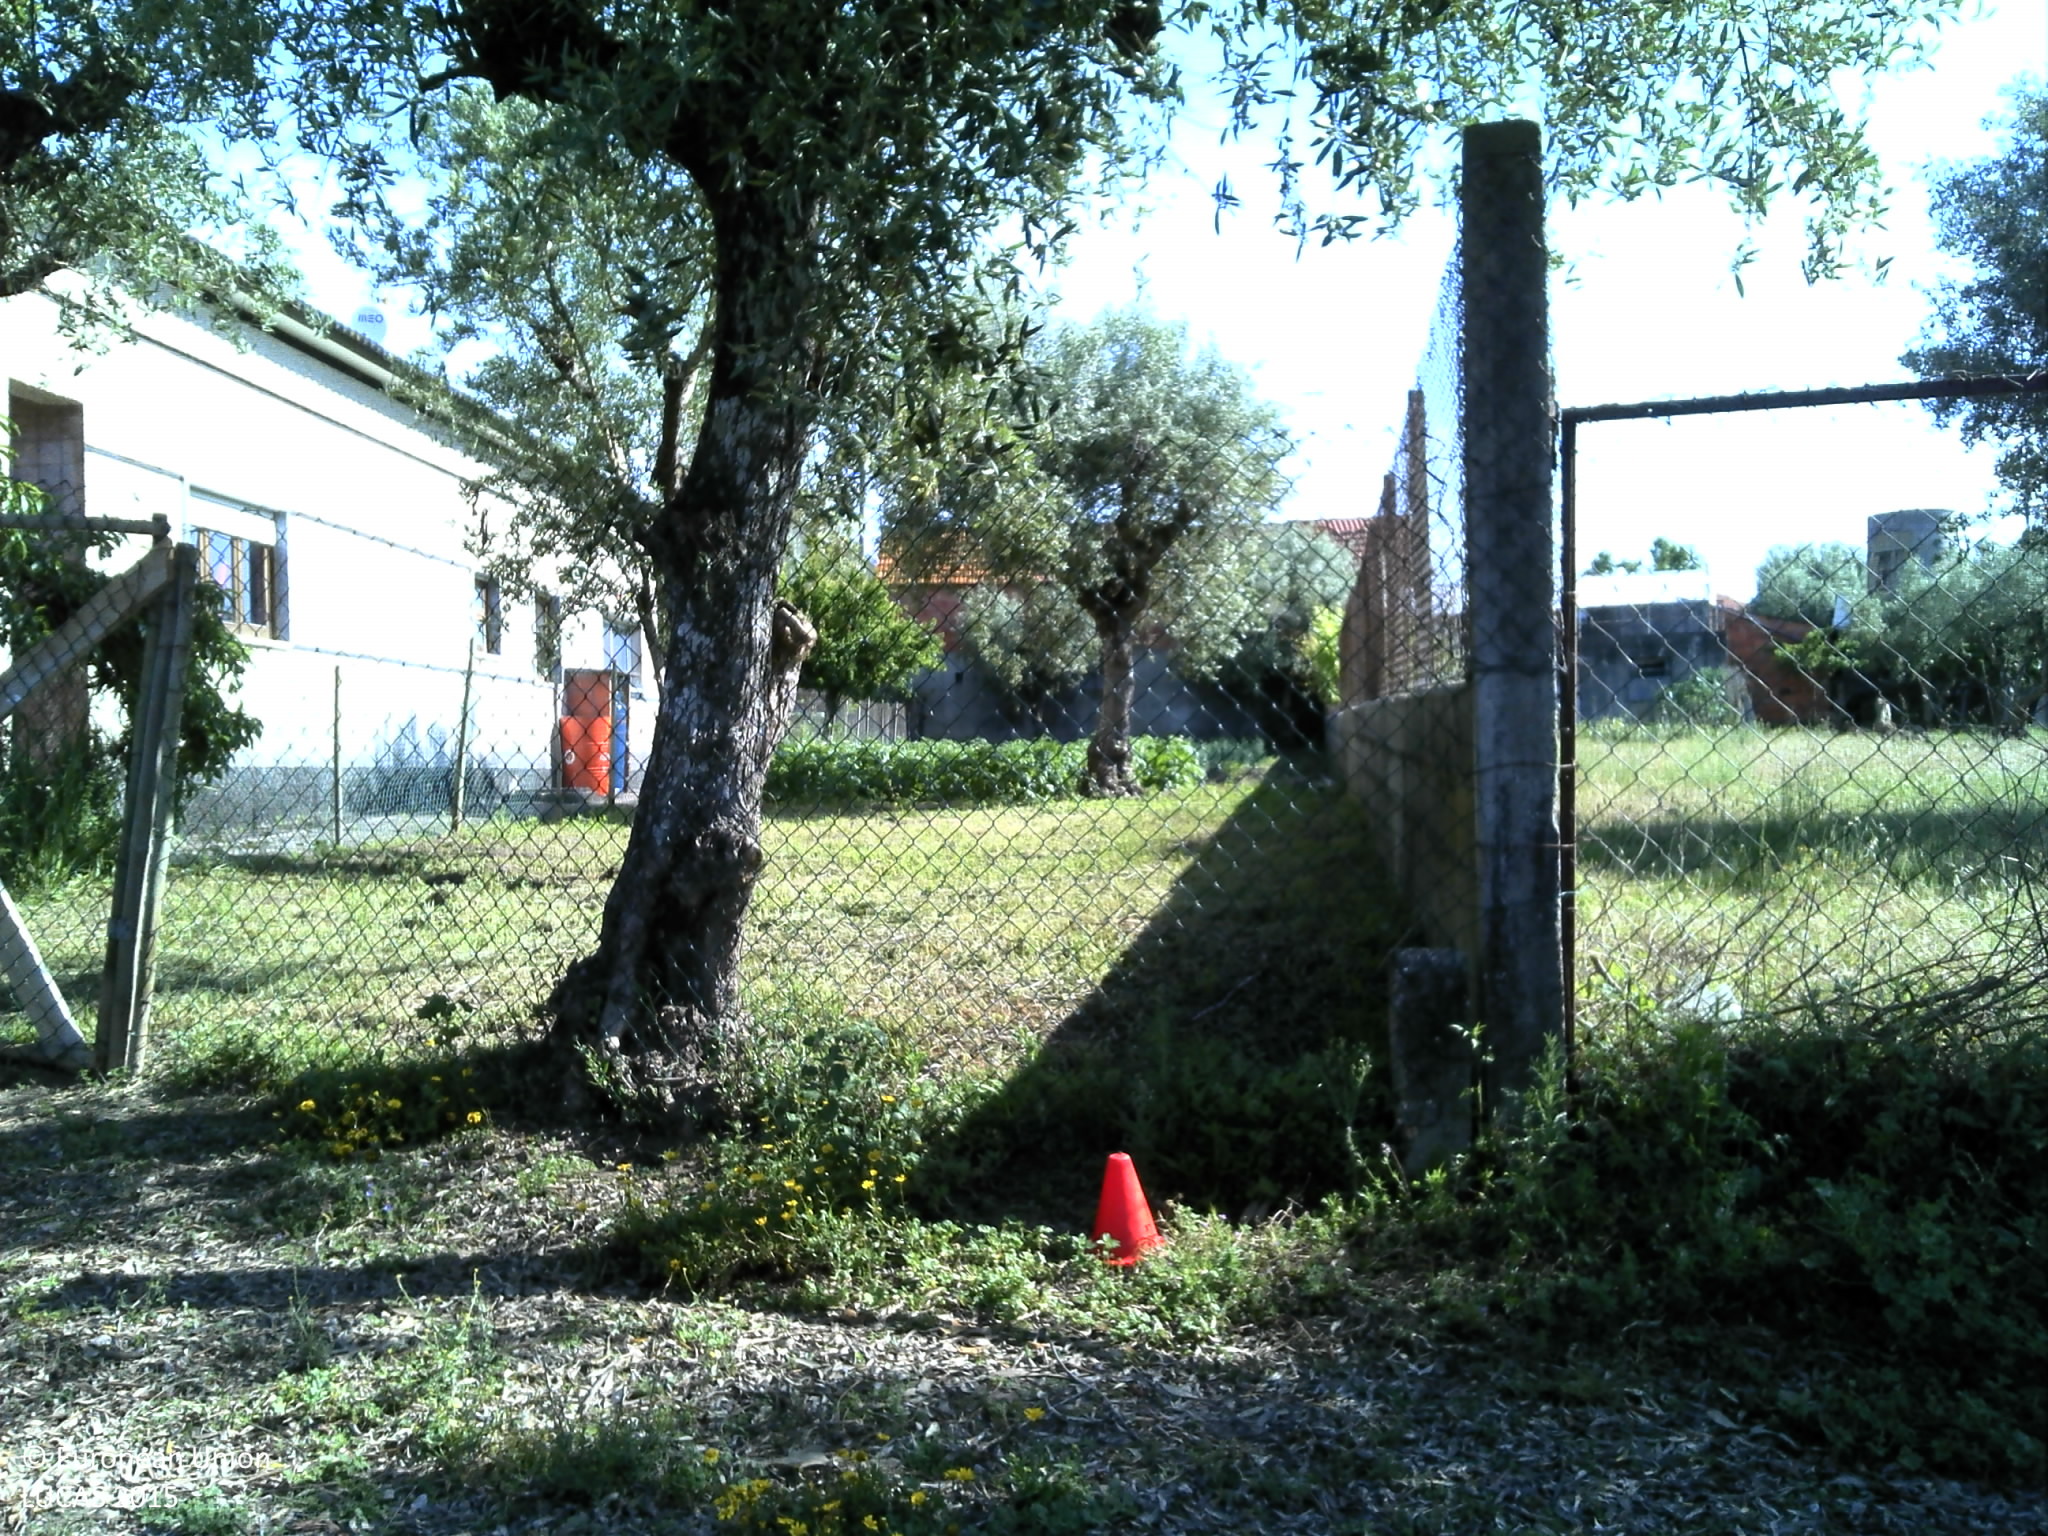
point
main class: Cropland
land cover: Potatoes
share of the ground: > 75 %
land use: Agriculture (excluding fallow land and kitchen gardens)
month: May
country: PT
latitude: 39.7565
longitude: -8.4595
